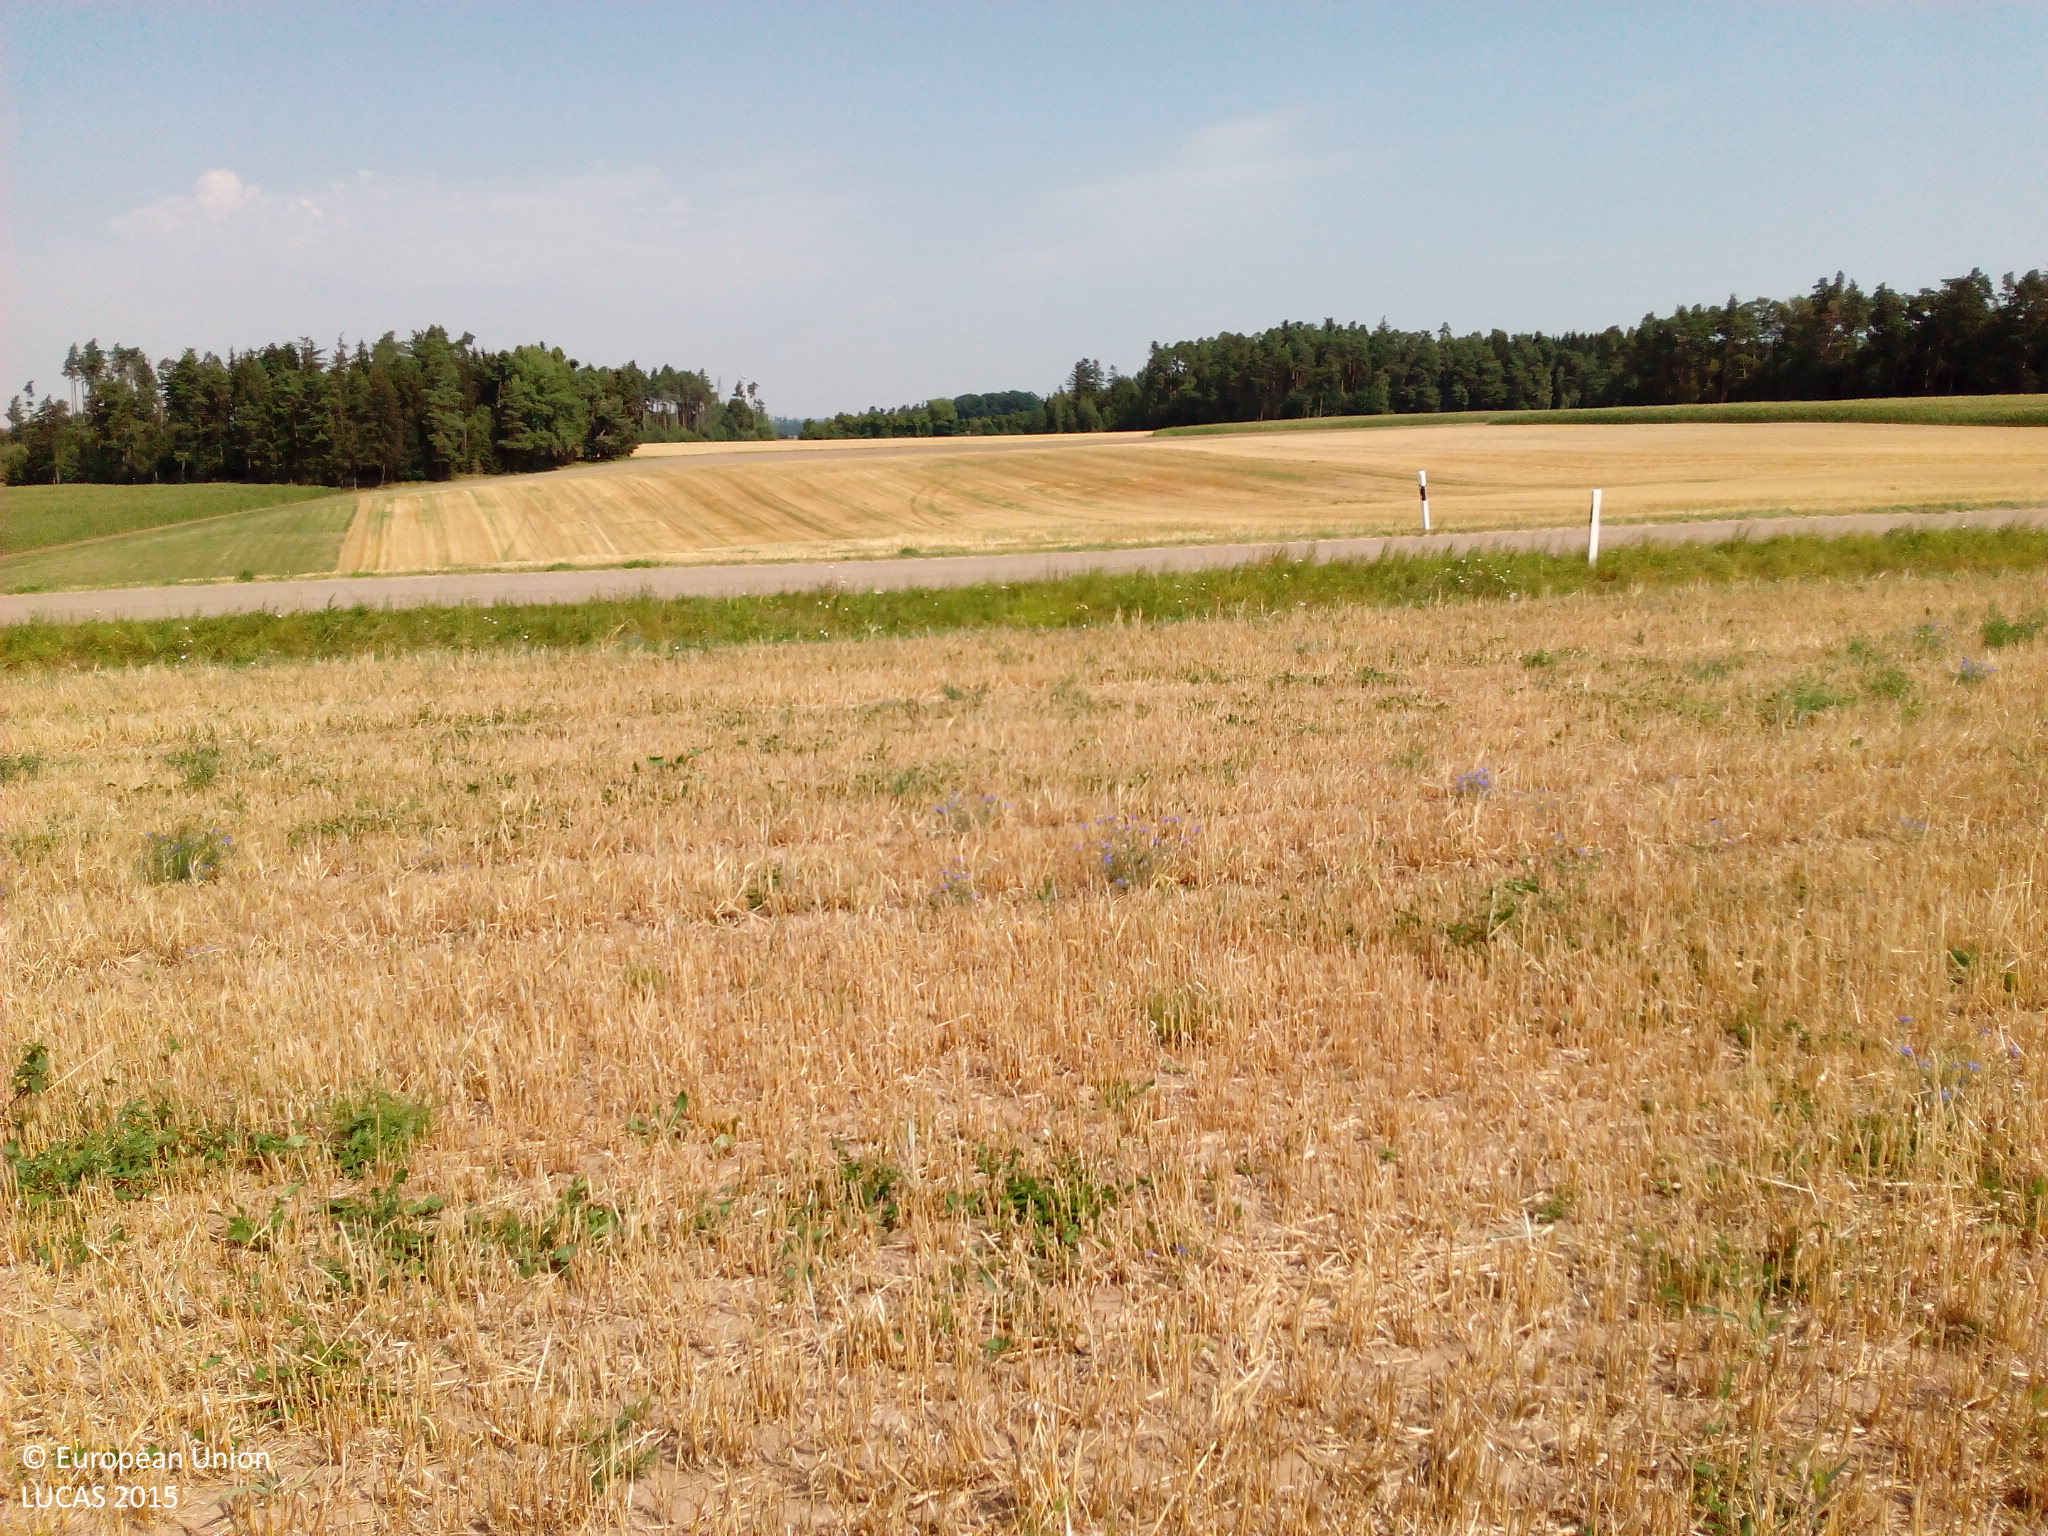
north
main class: Cropland
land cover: Barley
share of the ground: < 10 %
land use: Agriculture (excluding fallow land and kitchen gardens)
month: August
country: DE
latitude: 49.1048
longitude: 10.2601
